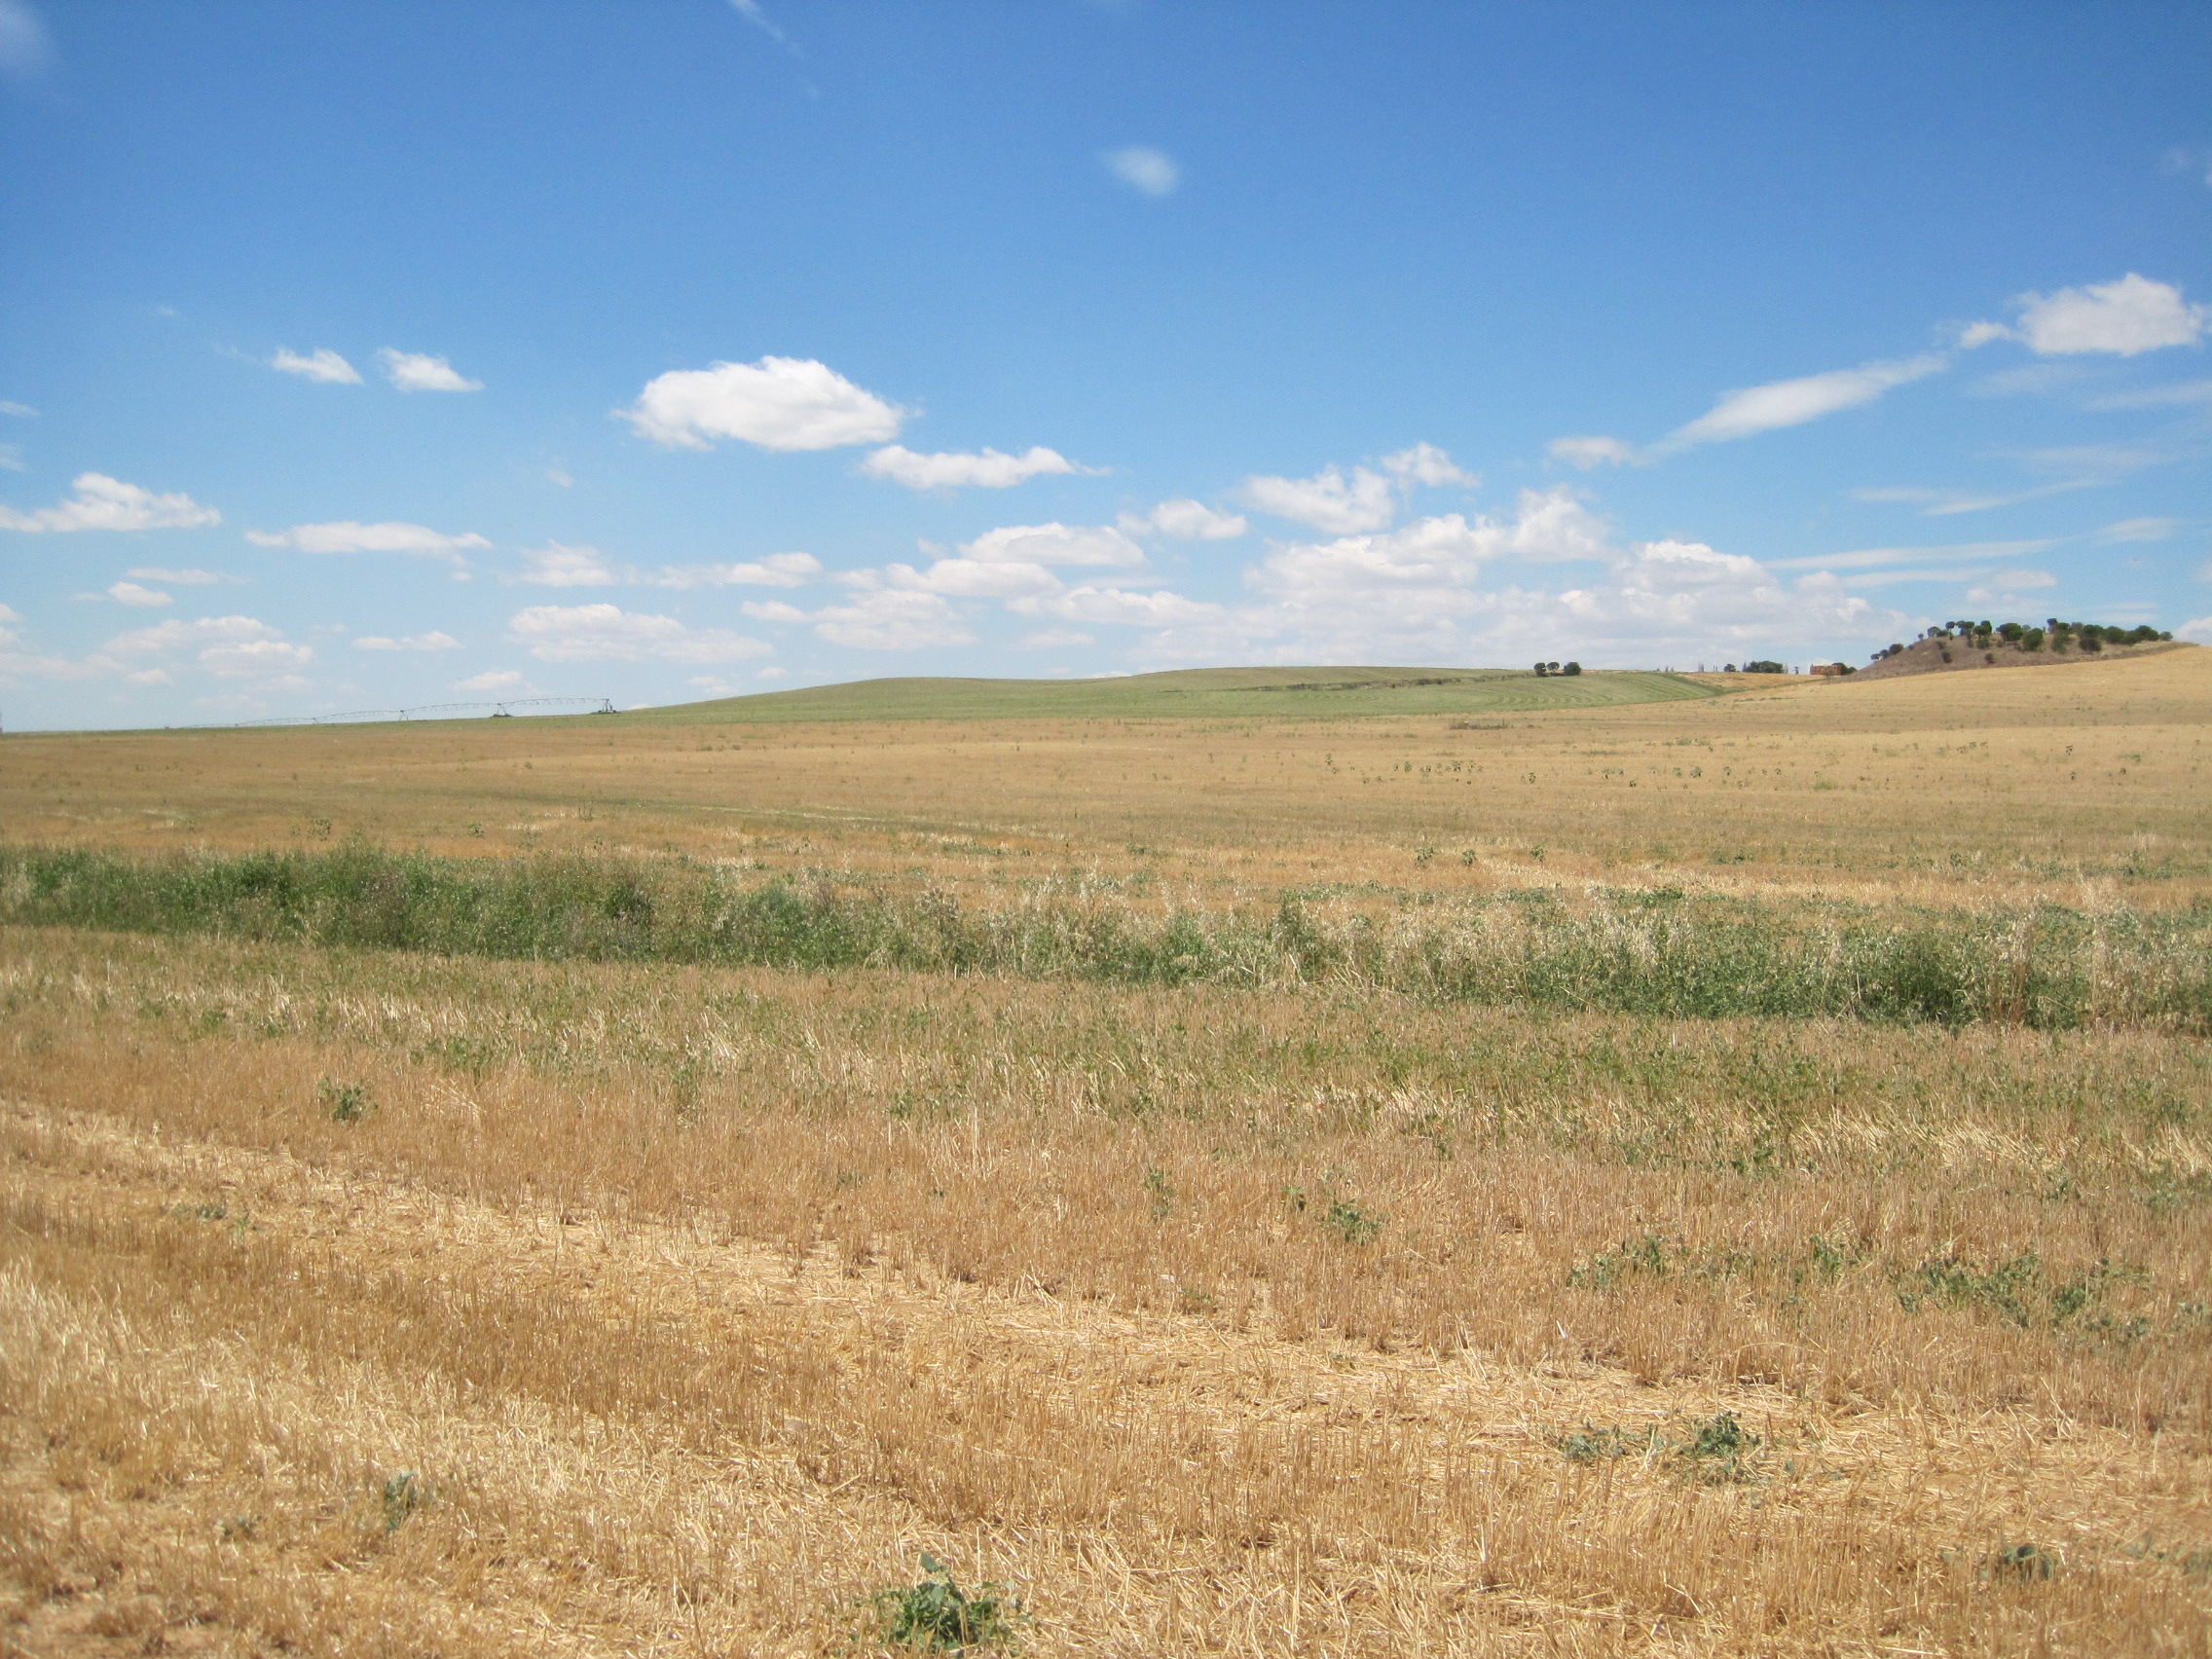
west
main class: Cropland
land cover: Barley
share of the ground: < 10 %
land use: Agriculture (excluding fallow land and kitchen gardens)
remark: Harvested field
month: July
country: ES
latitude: 42.0264
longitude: -5.5860
